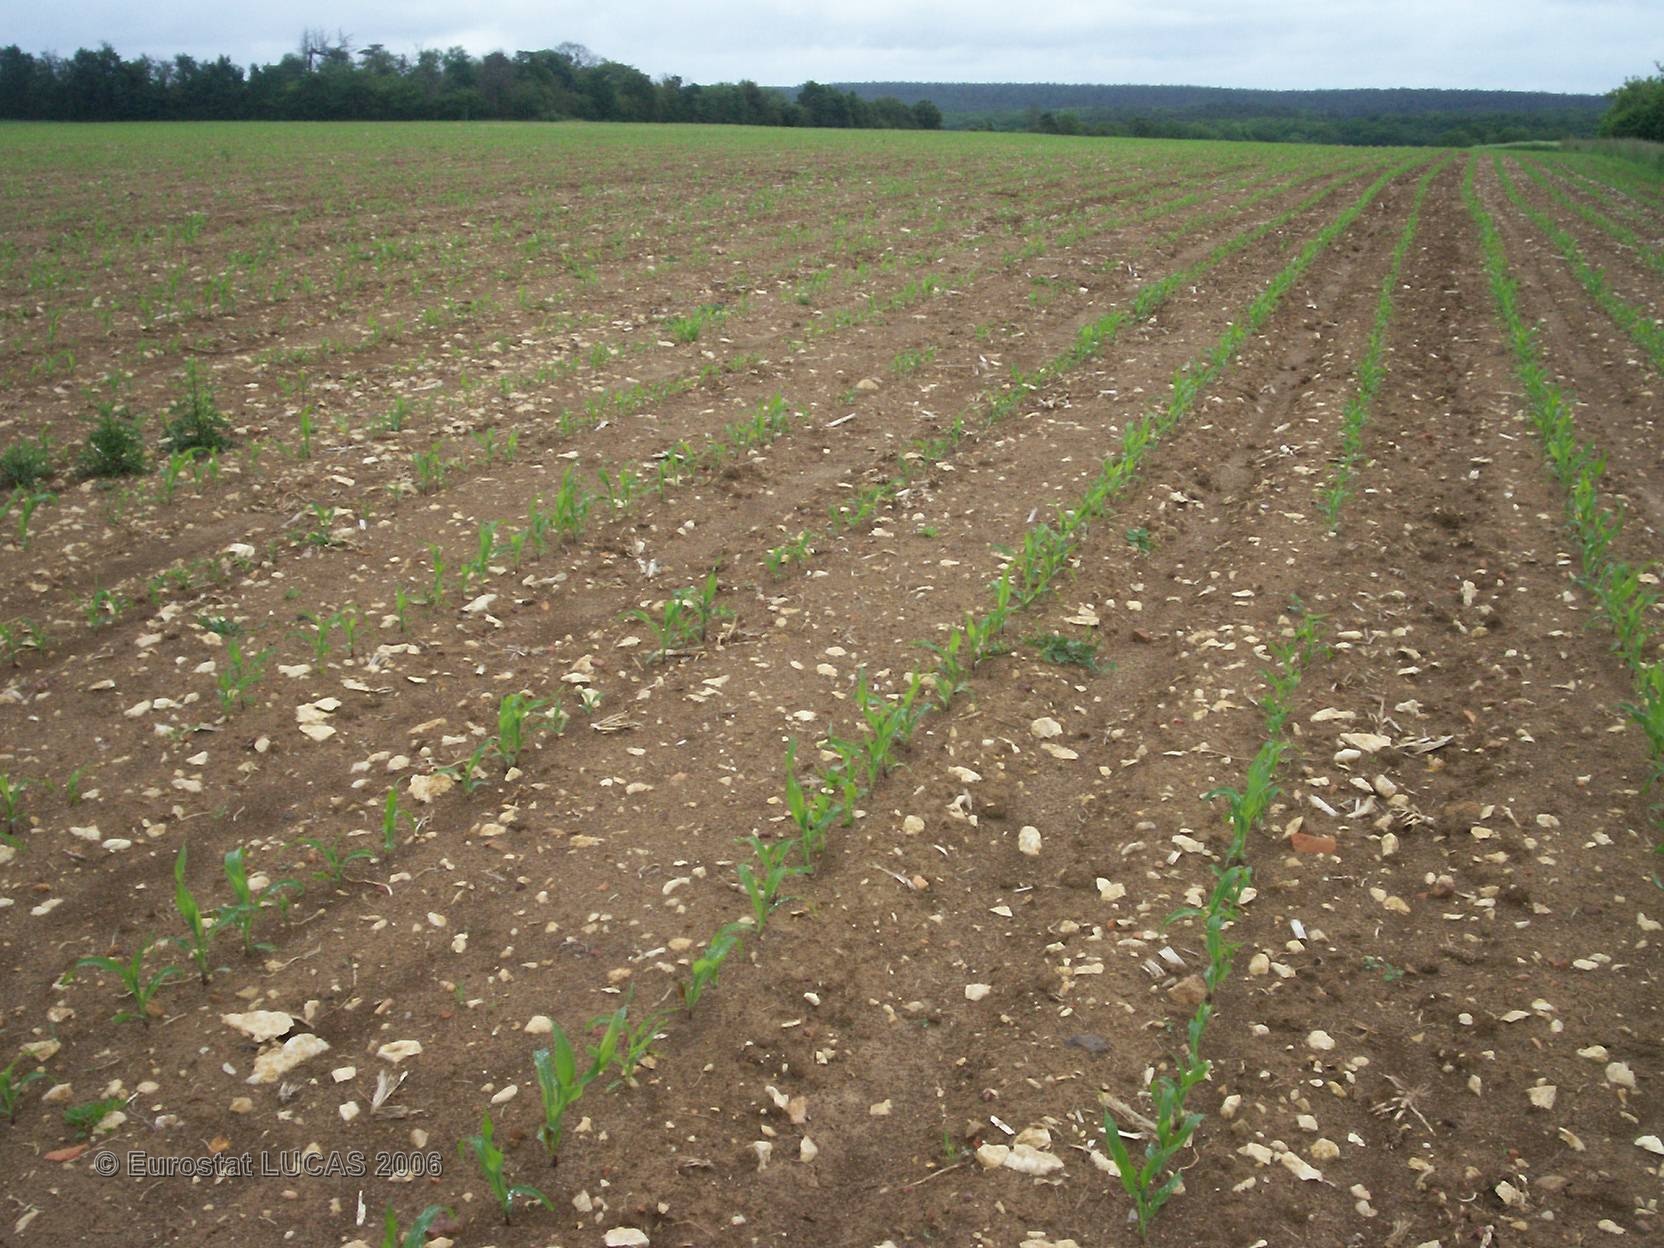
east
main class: Cropland
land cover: Maize
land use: Agriculture (excluding fallow land and kitchen gardens)
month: May
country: FR
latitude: 46.6666
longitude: 0.4533
